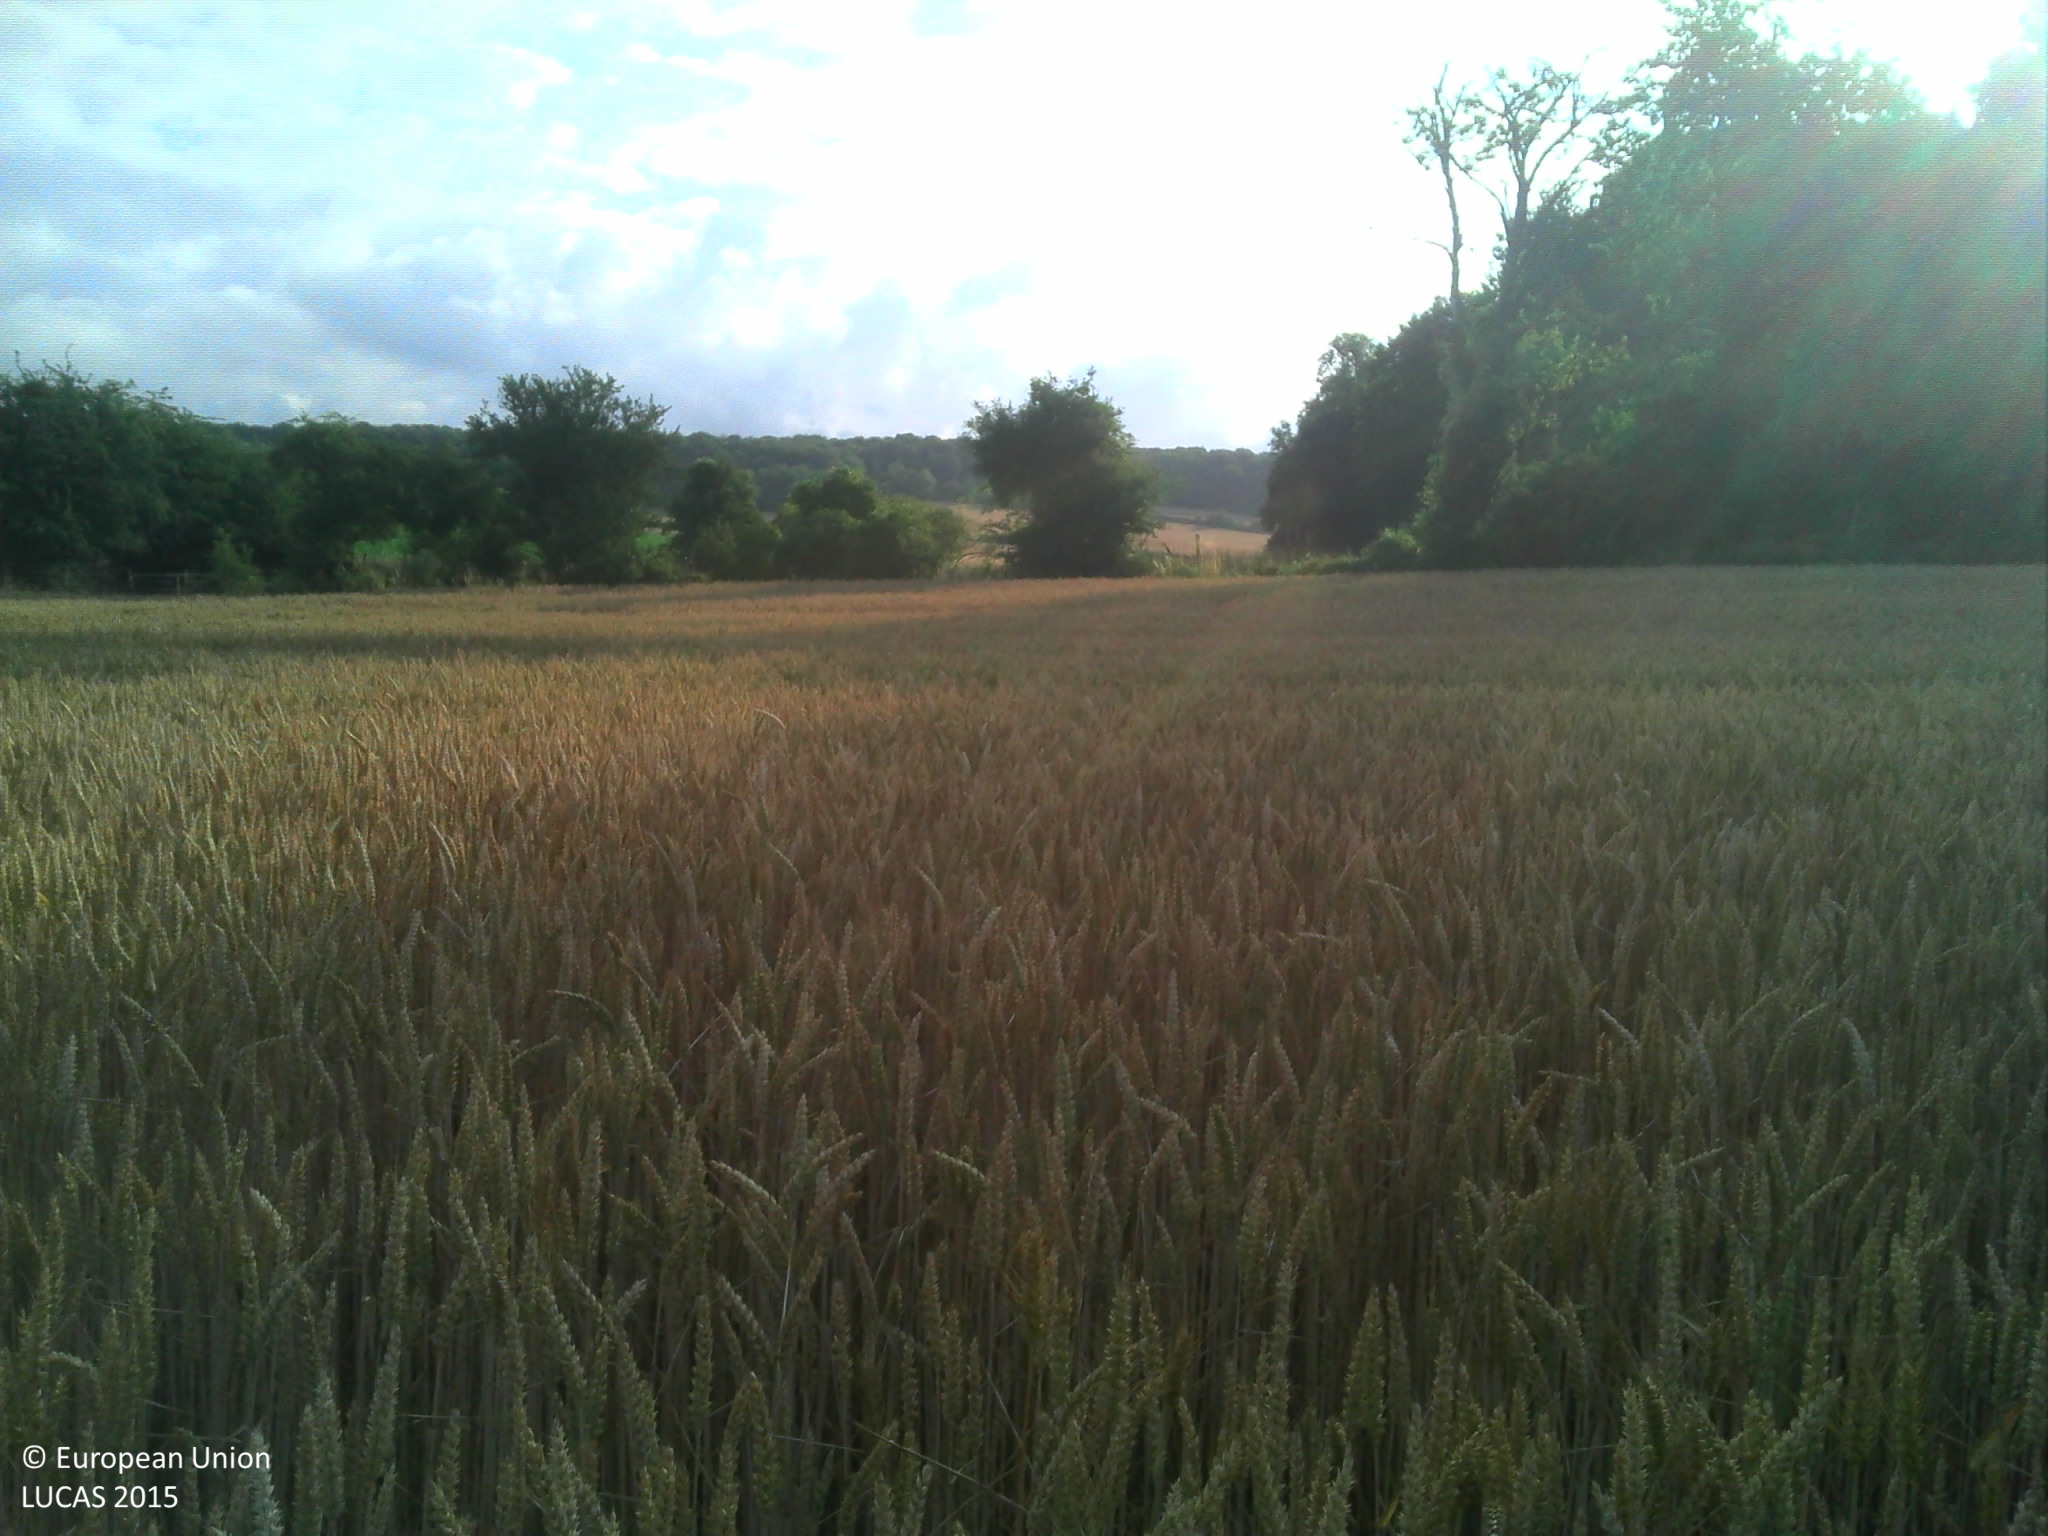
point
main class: Cropland
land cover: Common wheat
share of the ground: > 75 %
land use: Agriculture (excluding fallow land and kitchen gardens)
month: July
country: FR
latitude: 49.8993
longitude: 1.6990
